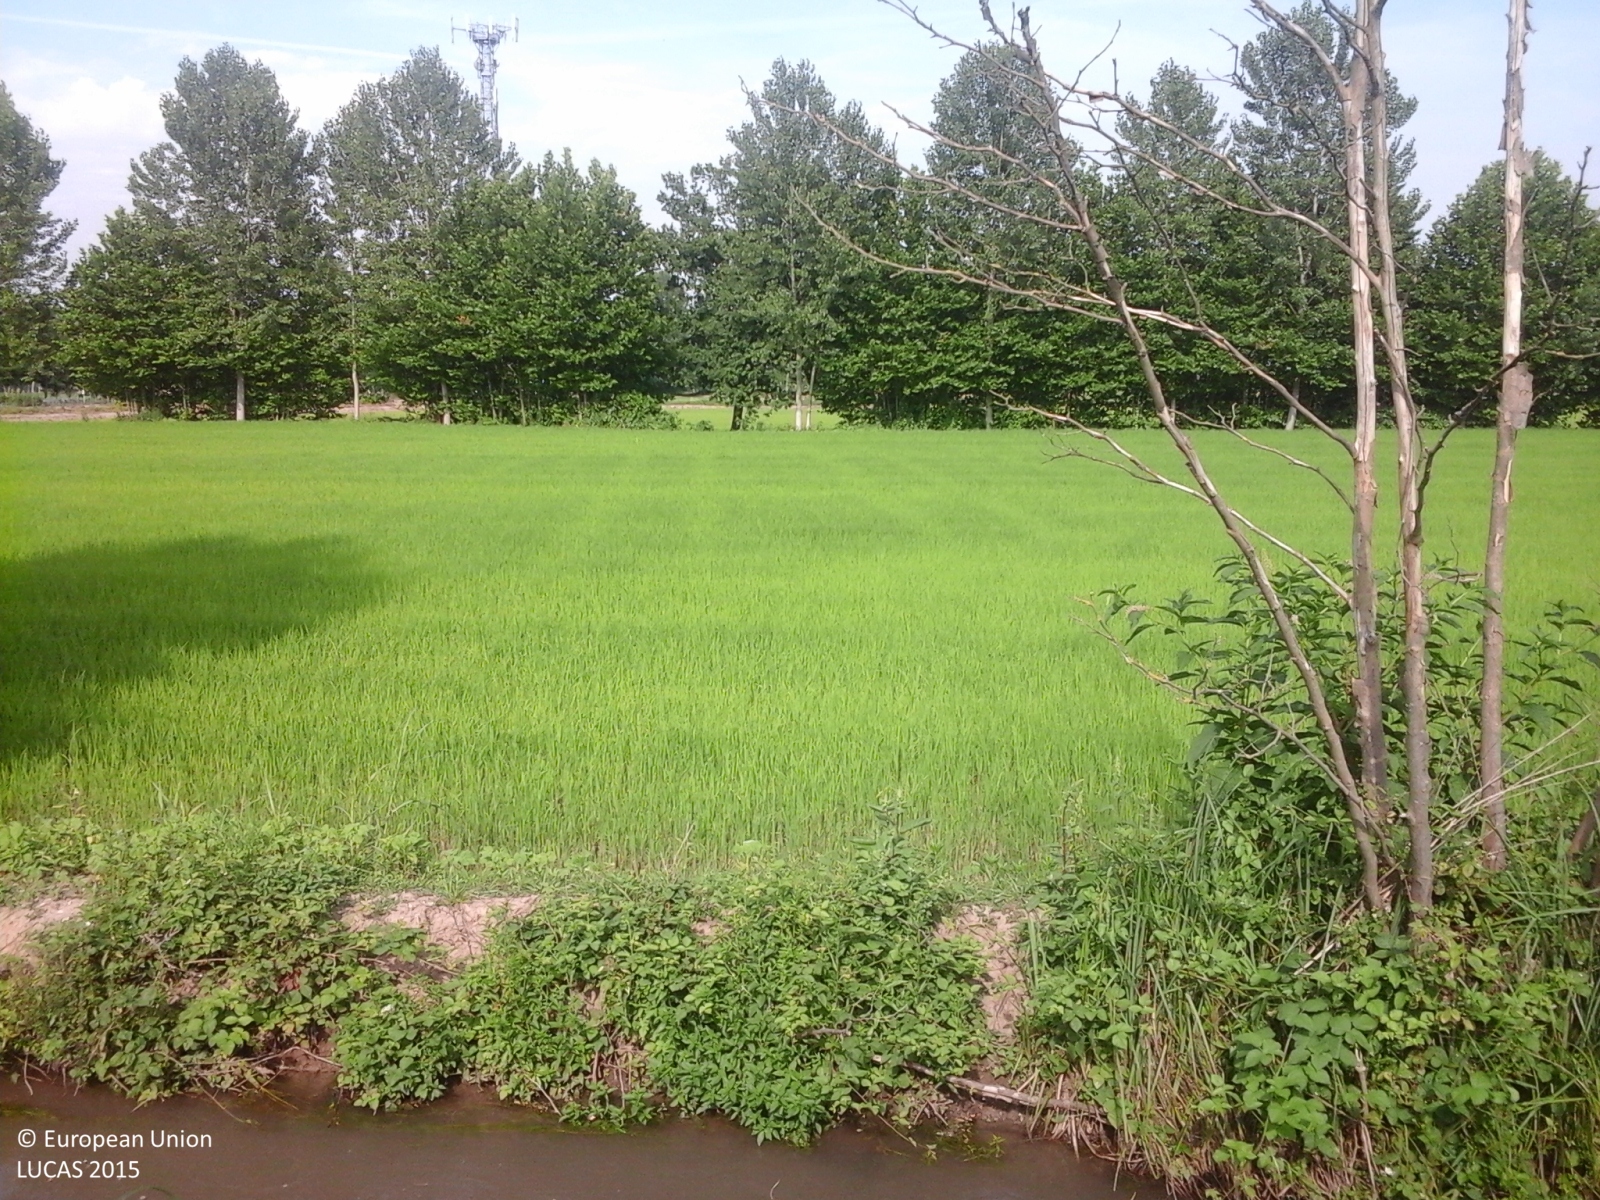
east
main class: Cropland
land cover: Rice
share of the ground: > 75 %
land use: Agriculture (excluding fallow land and kitchen gardens)
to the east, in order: Rice; Grass margins; Inland fresh running water; Abandoned hedges; Rice; Grass margins; Abandoned hedges; Inland fresh running water; Grass margins; Tracks; Rice; Grass margins; Ditches and canals; Grass margins; Tracks; Grass margins; Rice
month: June
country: IT
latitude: 45.3687
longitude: 8.5852
